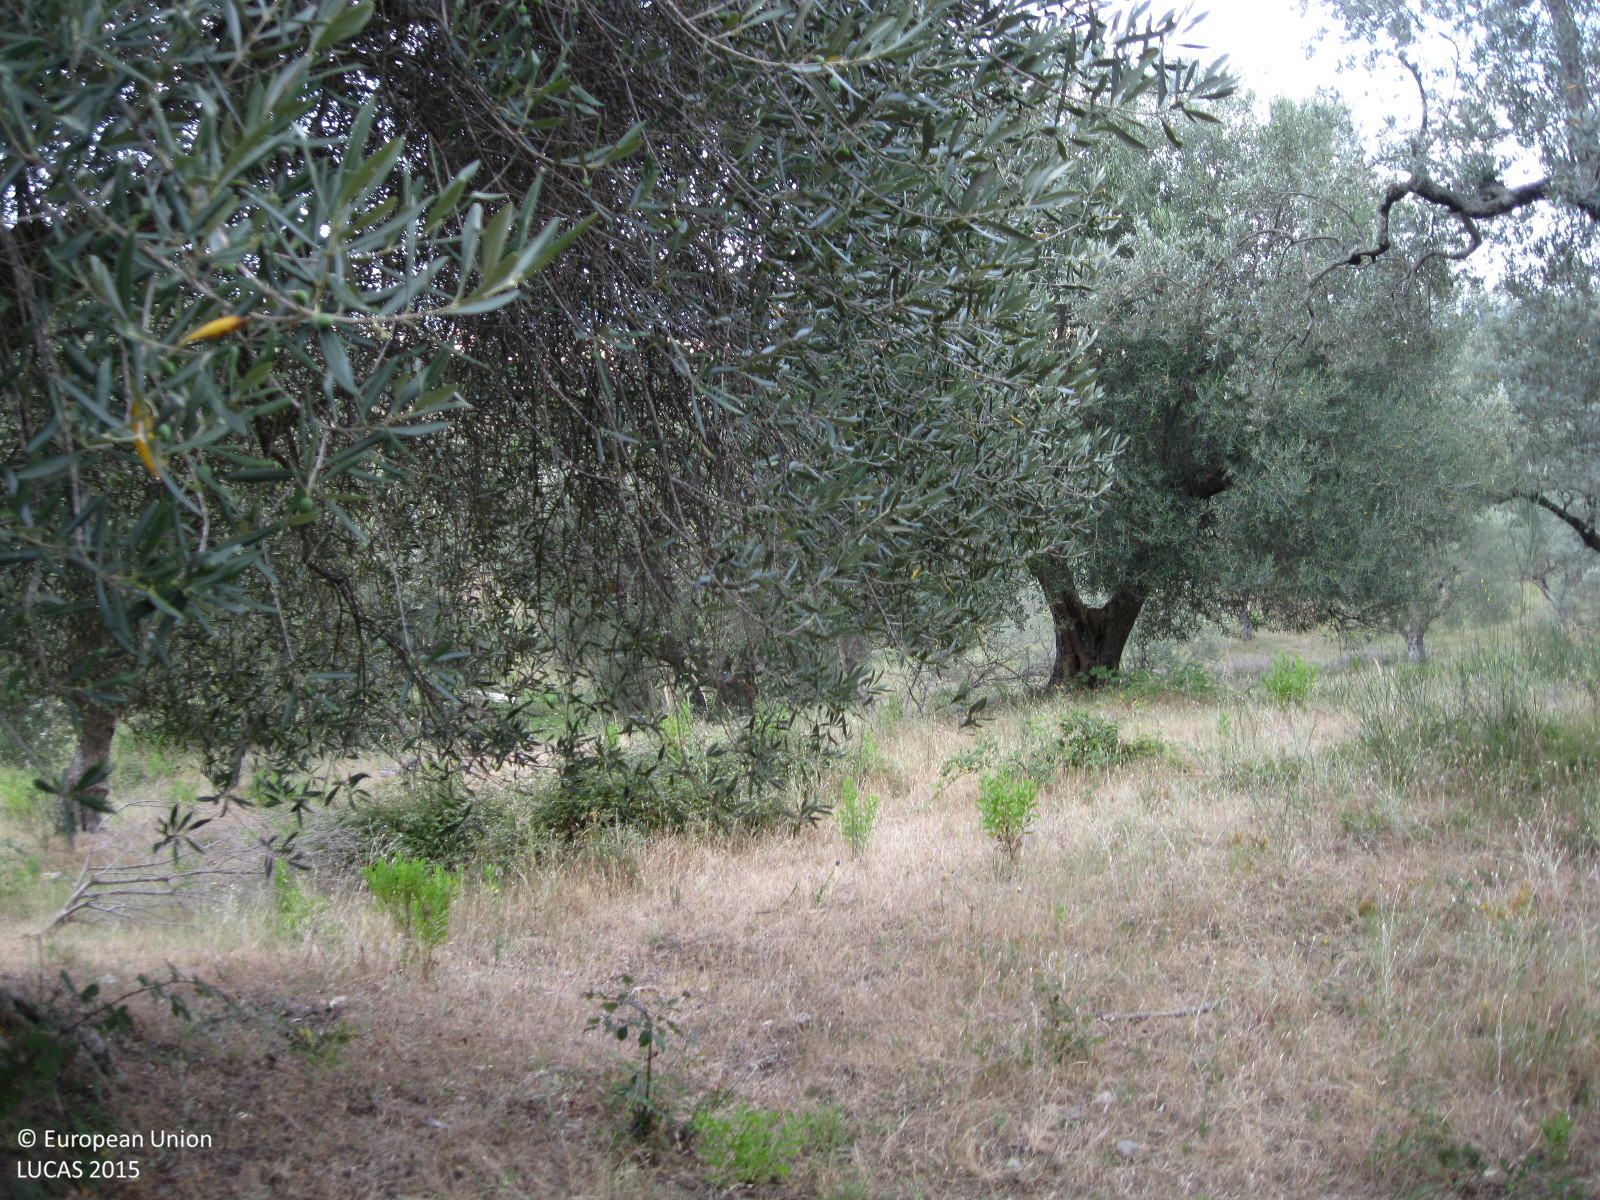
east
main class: Cropland
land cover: Olive groves
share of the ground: > 75 %
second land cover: Grassland without tree/shrub cover
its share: 50 - 75 %
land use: Agriculture (excluding fallow land and kitchen gardens)
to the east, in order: Olive groves; Grassland without tree/shrub cover; Abandoned hedges; Grassland without tree/shrub cover; Broadleaved woodland
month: July
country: IT
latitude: 42.6979
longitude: 11.4479
